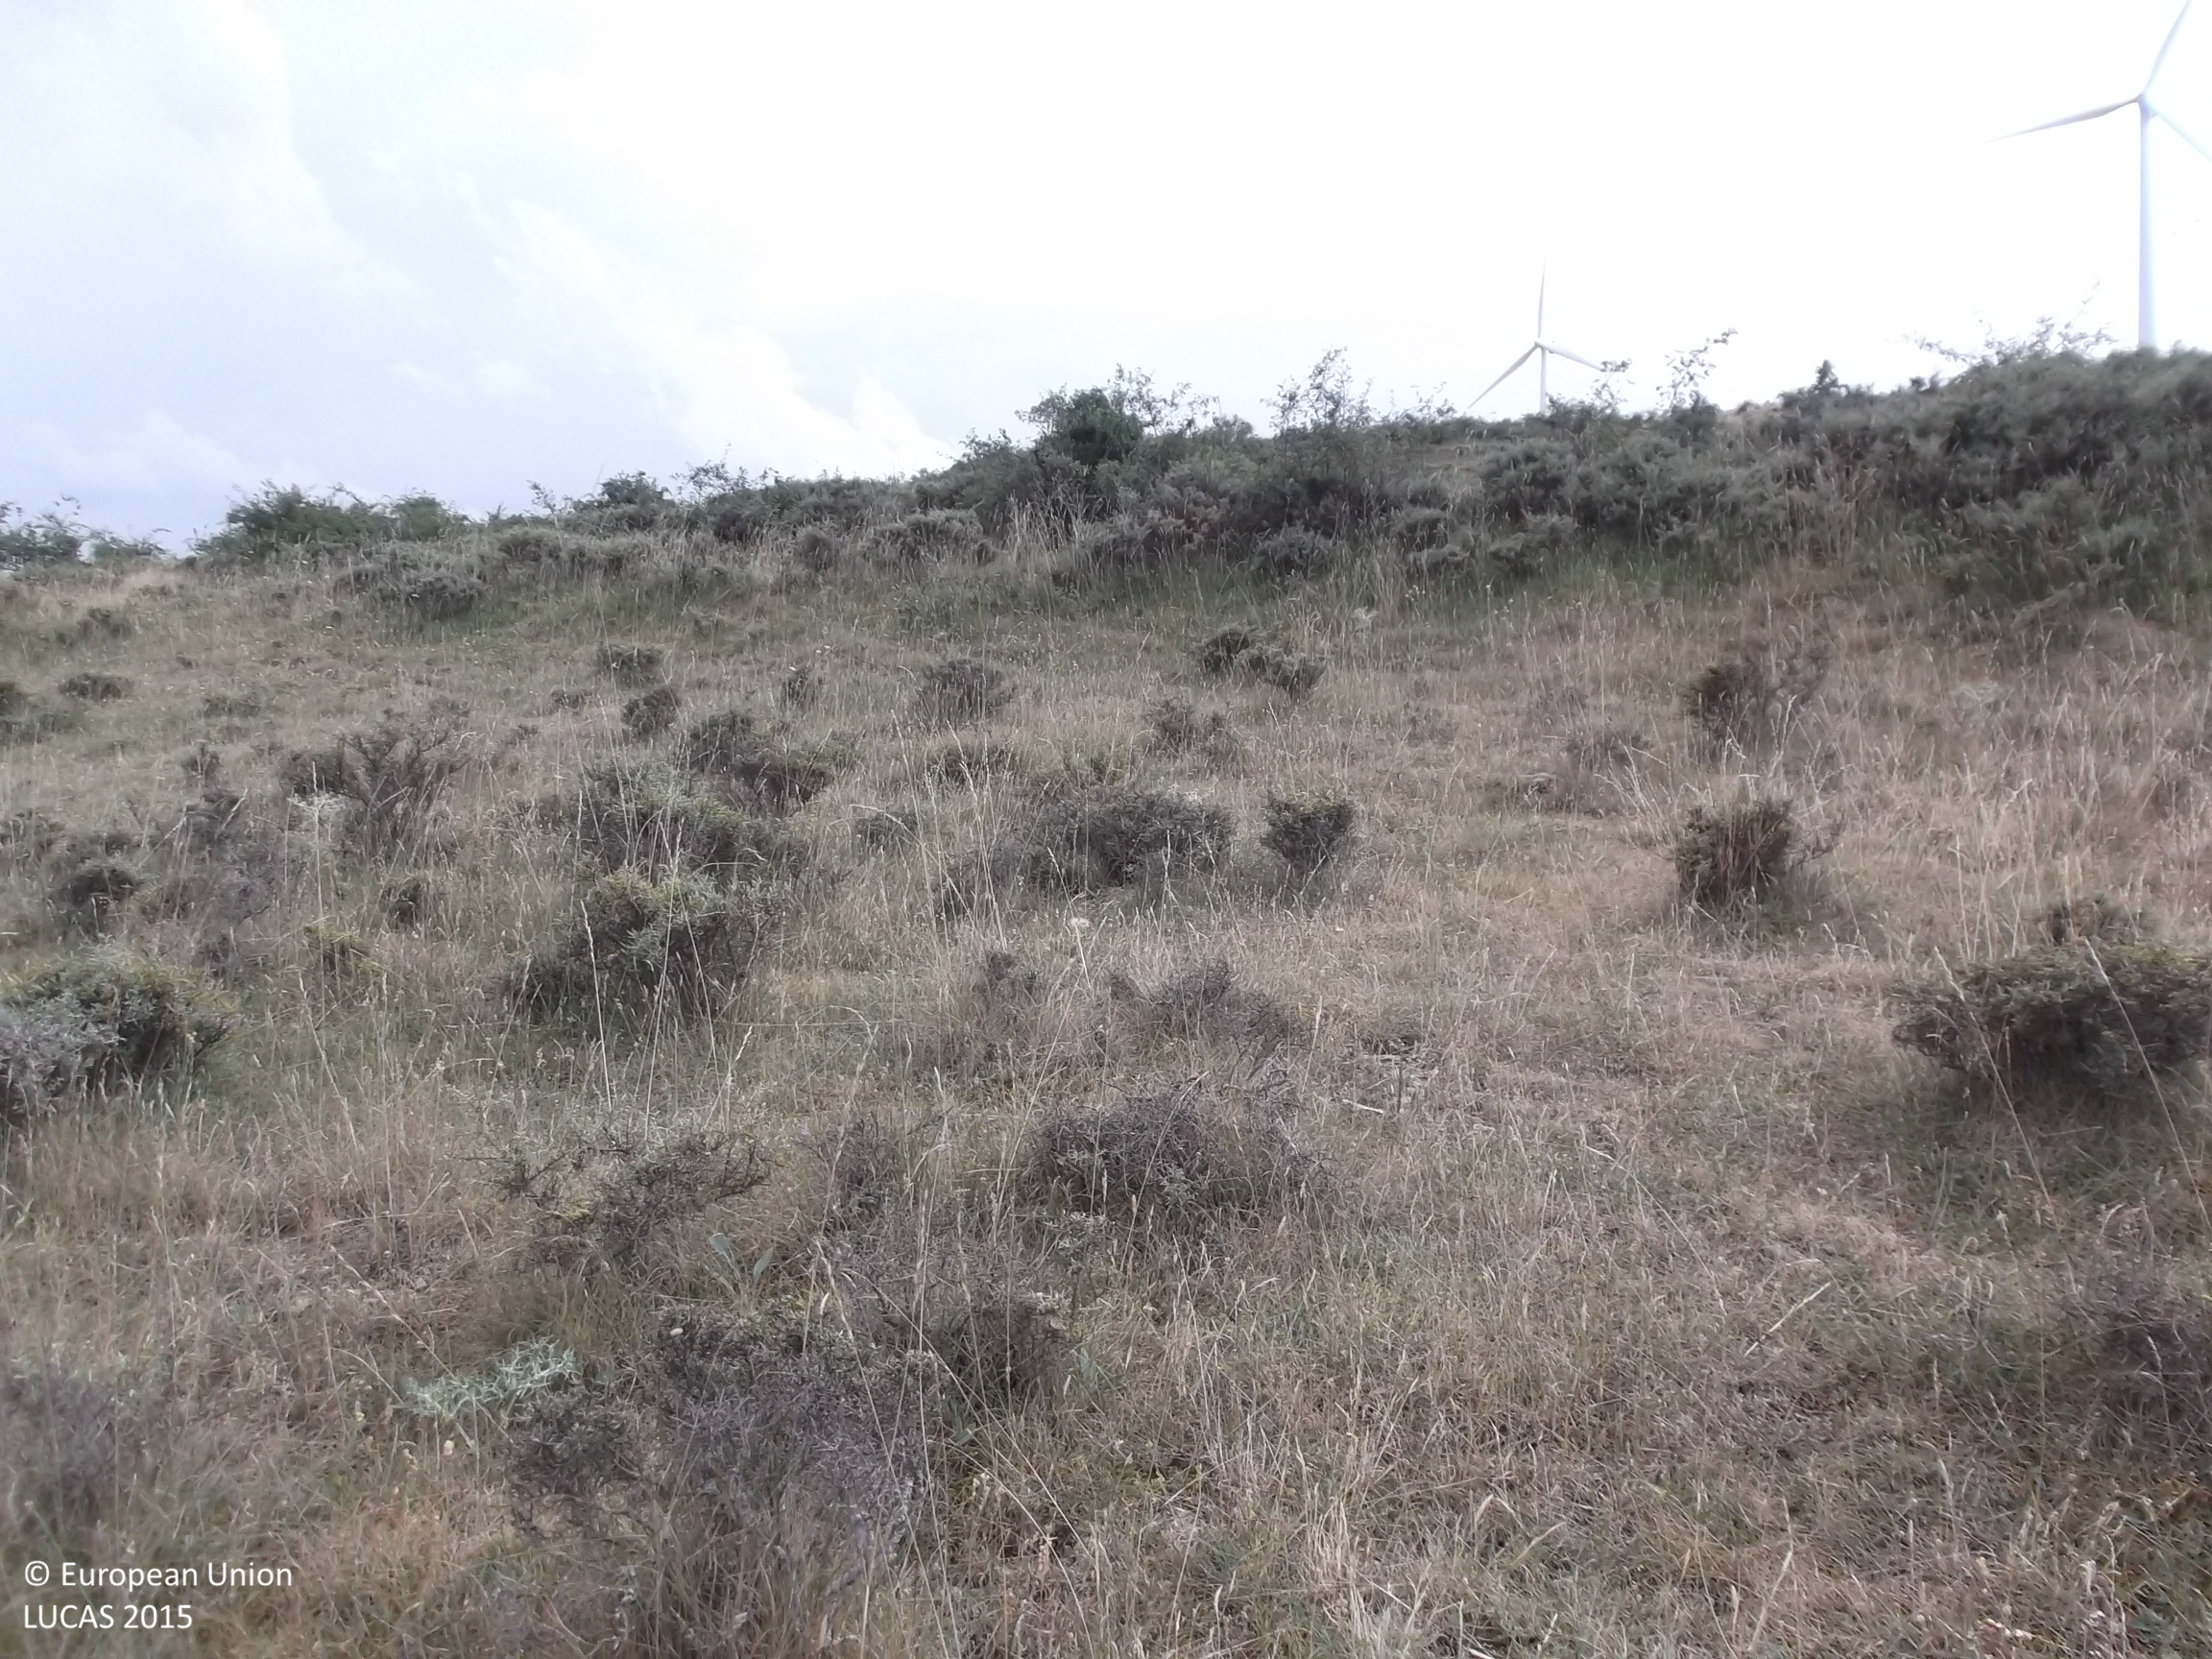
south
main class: Shrubland
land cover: Shrubland without tree cover
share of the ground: 25 - 50 %
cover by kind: shrubs 45 %, herbaceous plants 40 %, unconsolidated bare surface 10 %
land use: Abandoned areas
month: July
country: ES
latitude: 41.9817
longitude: -2.2397
